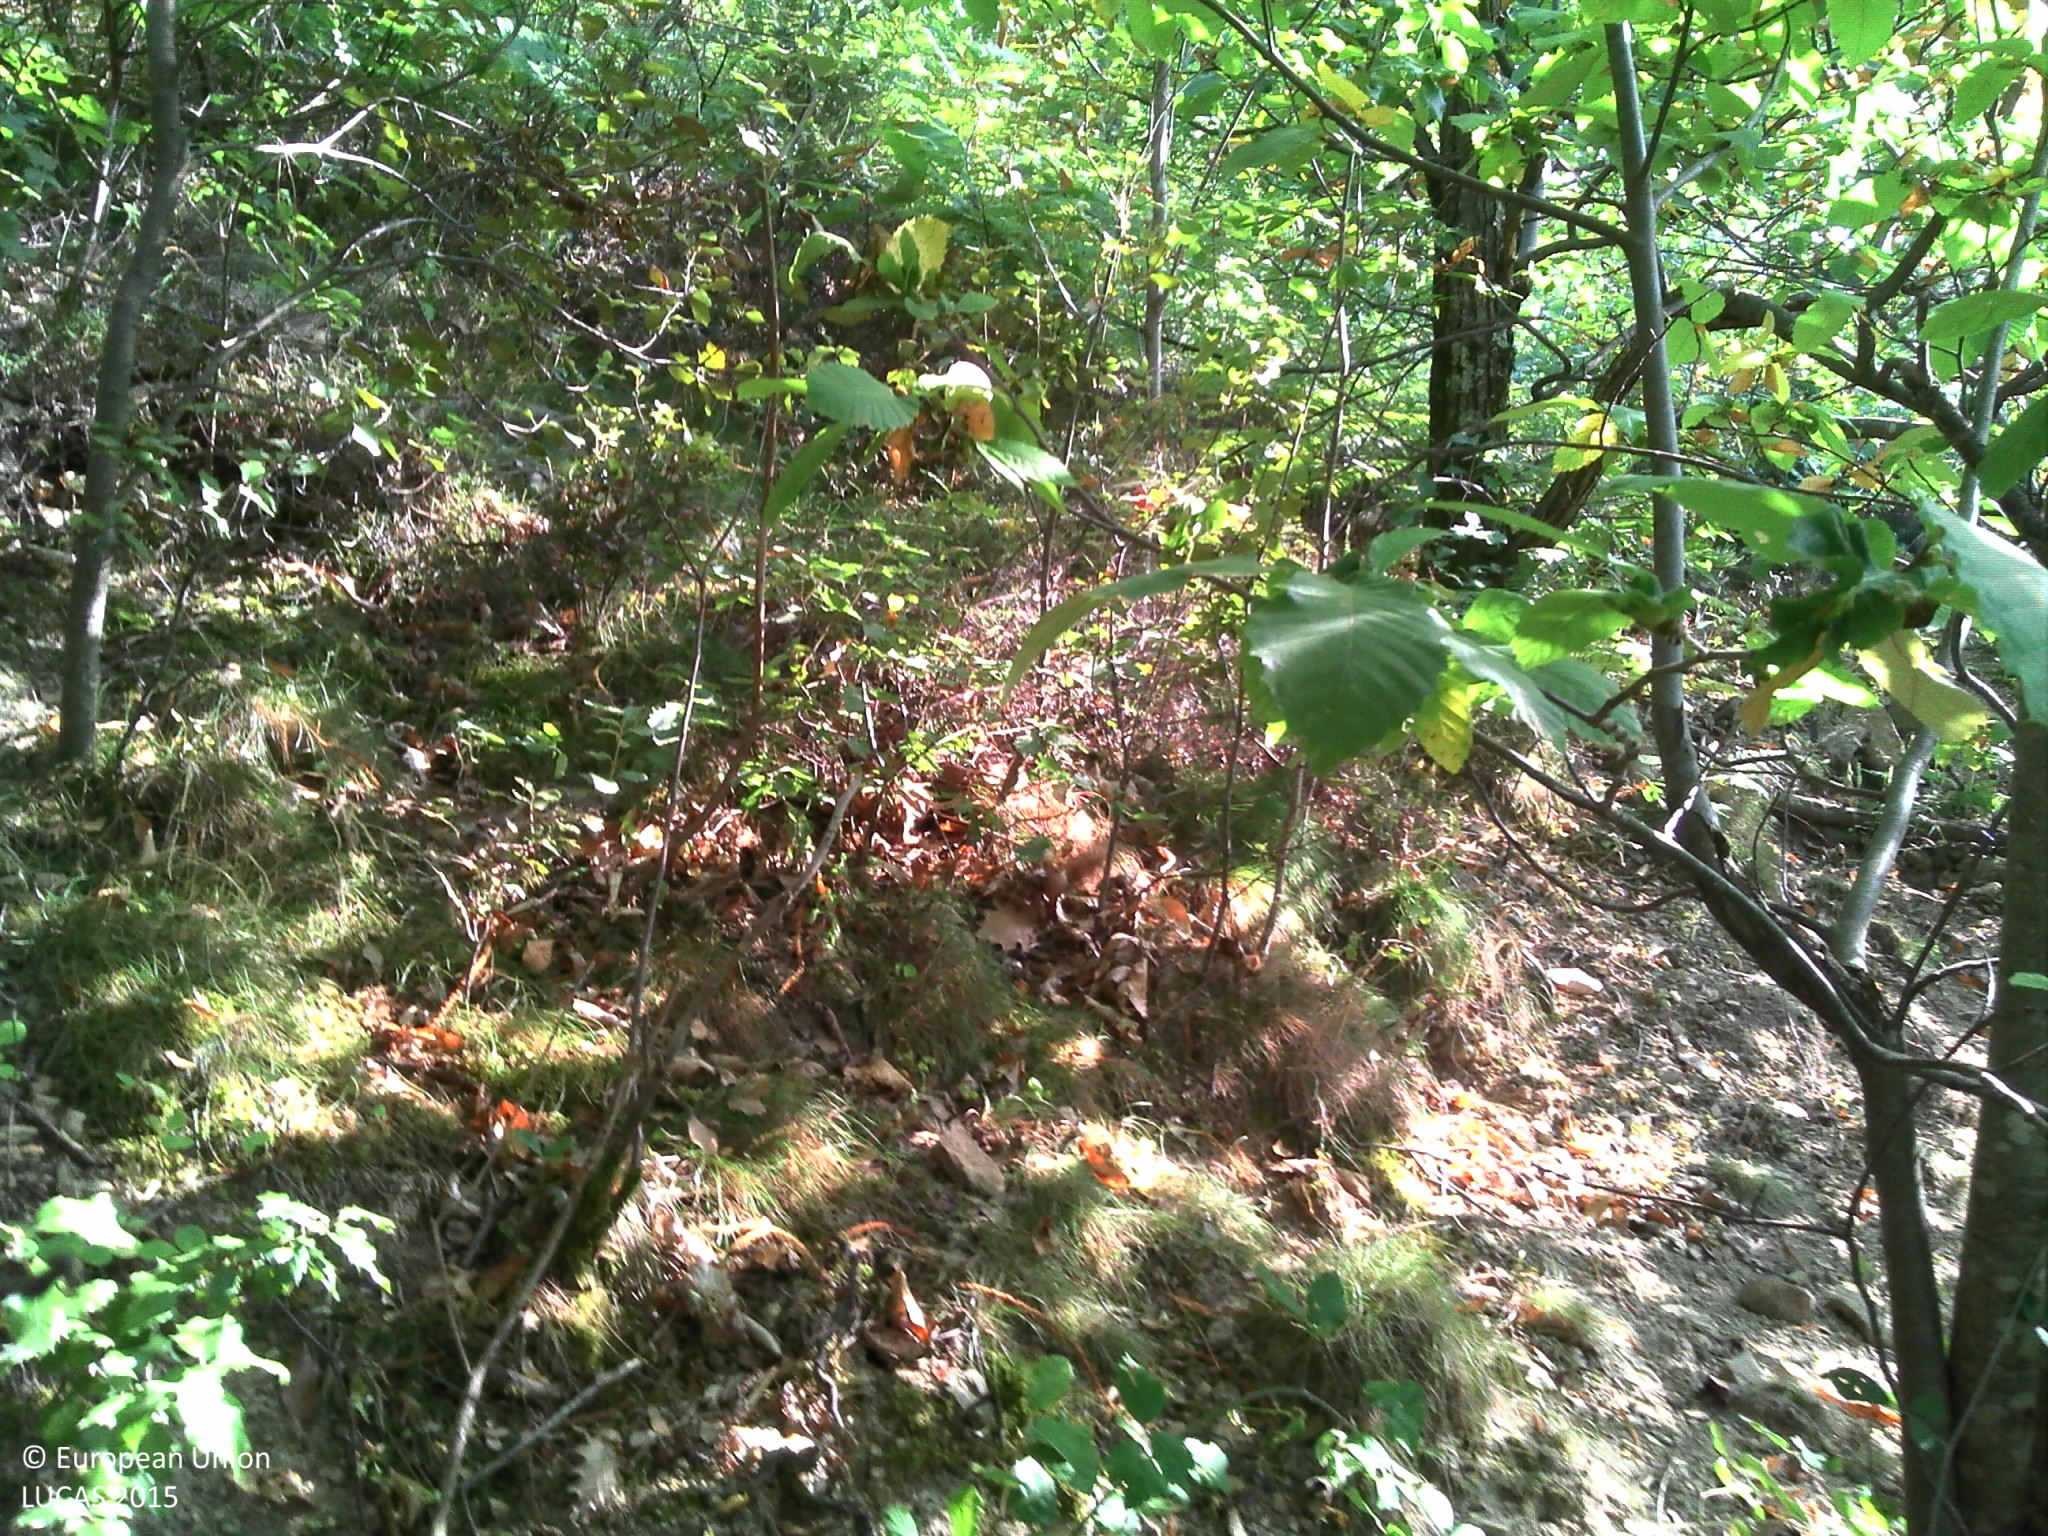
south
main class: Woodland
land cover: Broadleaved woodland
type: broadleaved evergreen forest
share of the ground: > 75 %
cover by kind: broadleaved forest trees 100 %
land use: Forestry
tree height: > 5 m
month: July
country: FR
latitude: 44.5736
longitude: 4.3017
